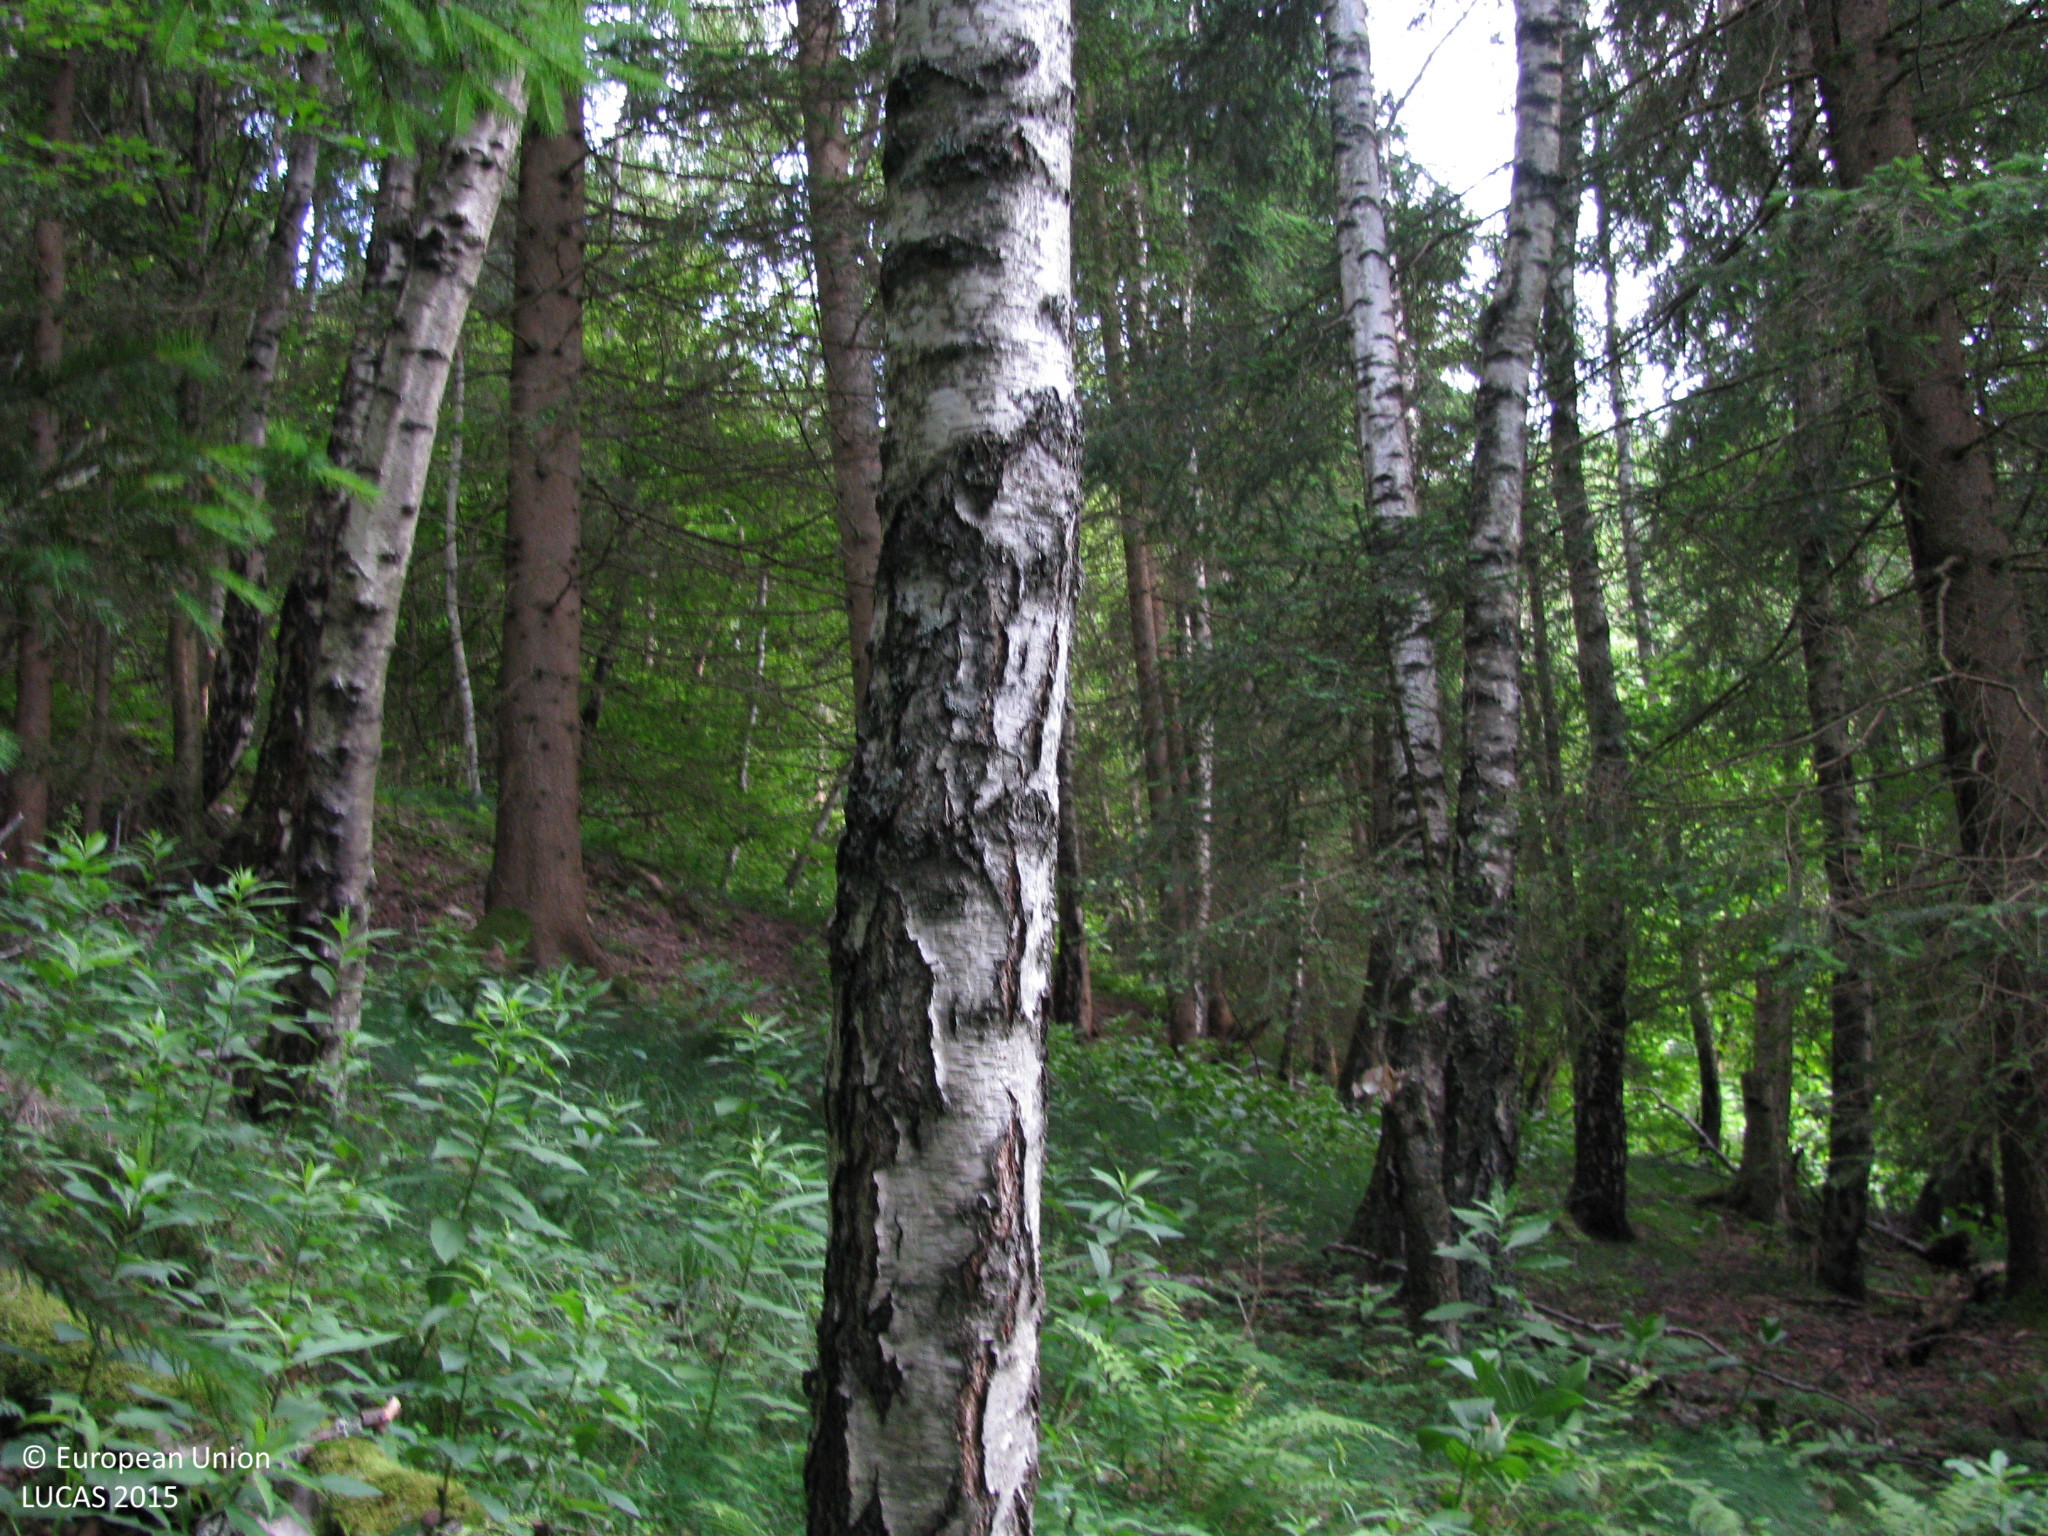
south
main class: Woodland
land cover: Spruce dominated mixed woodland
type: mire and swamp forests
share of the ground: 50 - 75 %
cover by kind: coniferous forest trees 35 %, broadleaved forest trees 35 %, herbaceous plants 30 %
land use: Forestry
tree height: > 5 m
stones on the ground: < 10 %
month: June
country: AT
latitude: 47.2427
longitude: 14.6359
